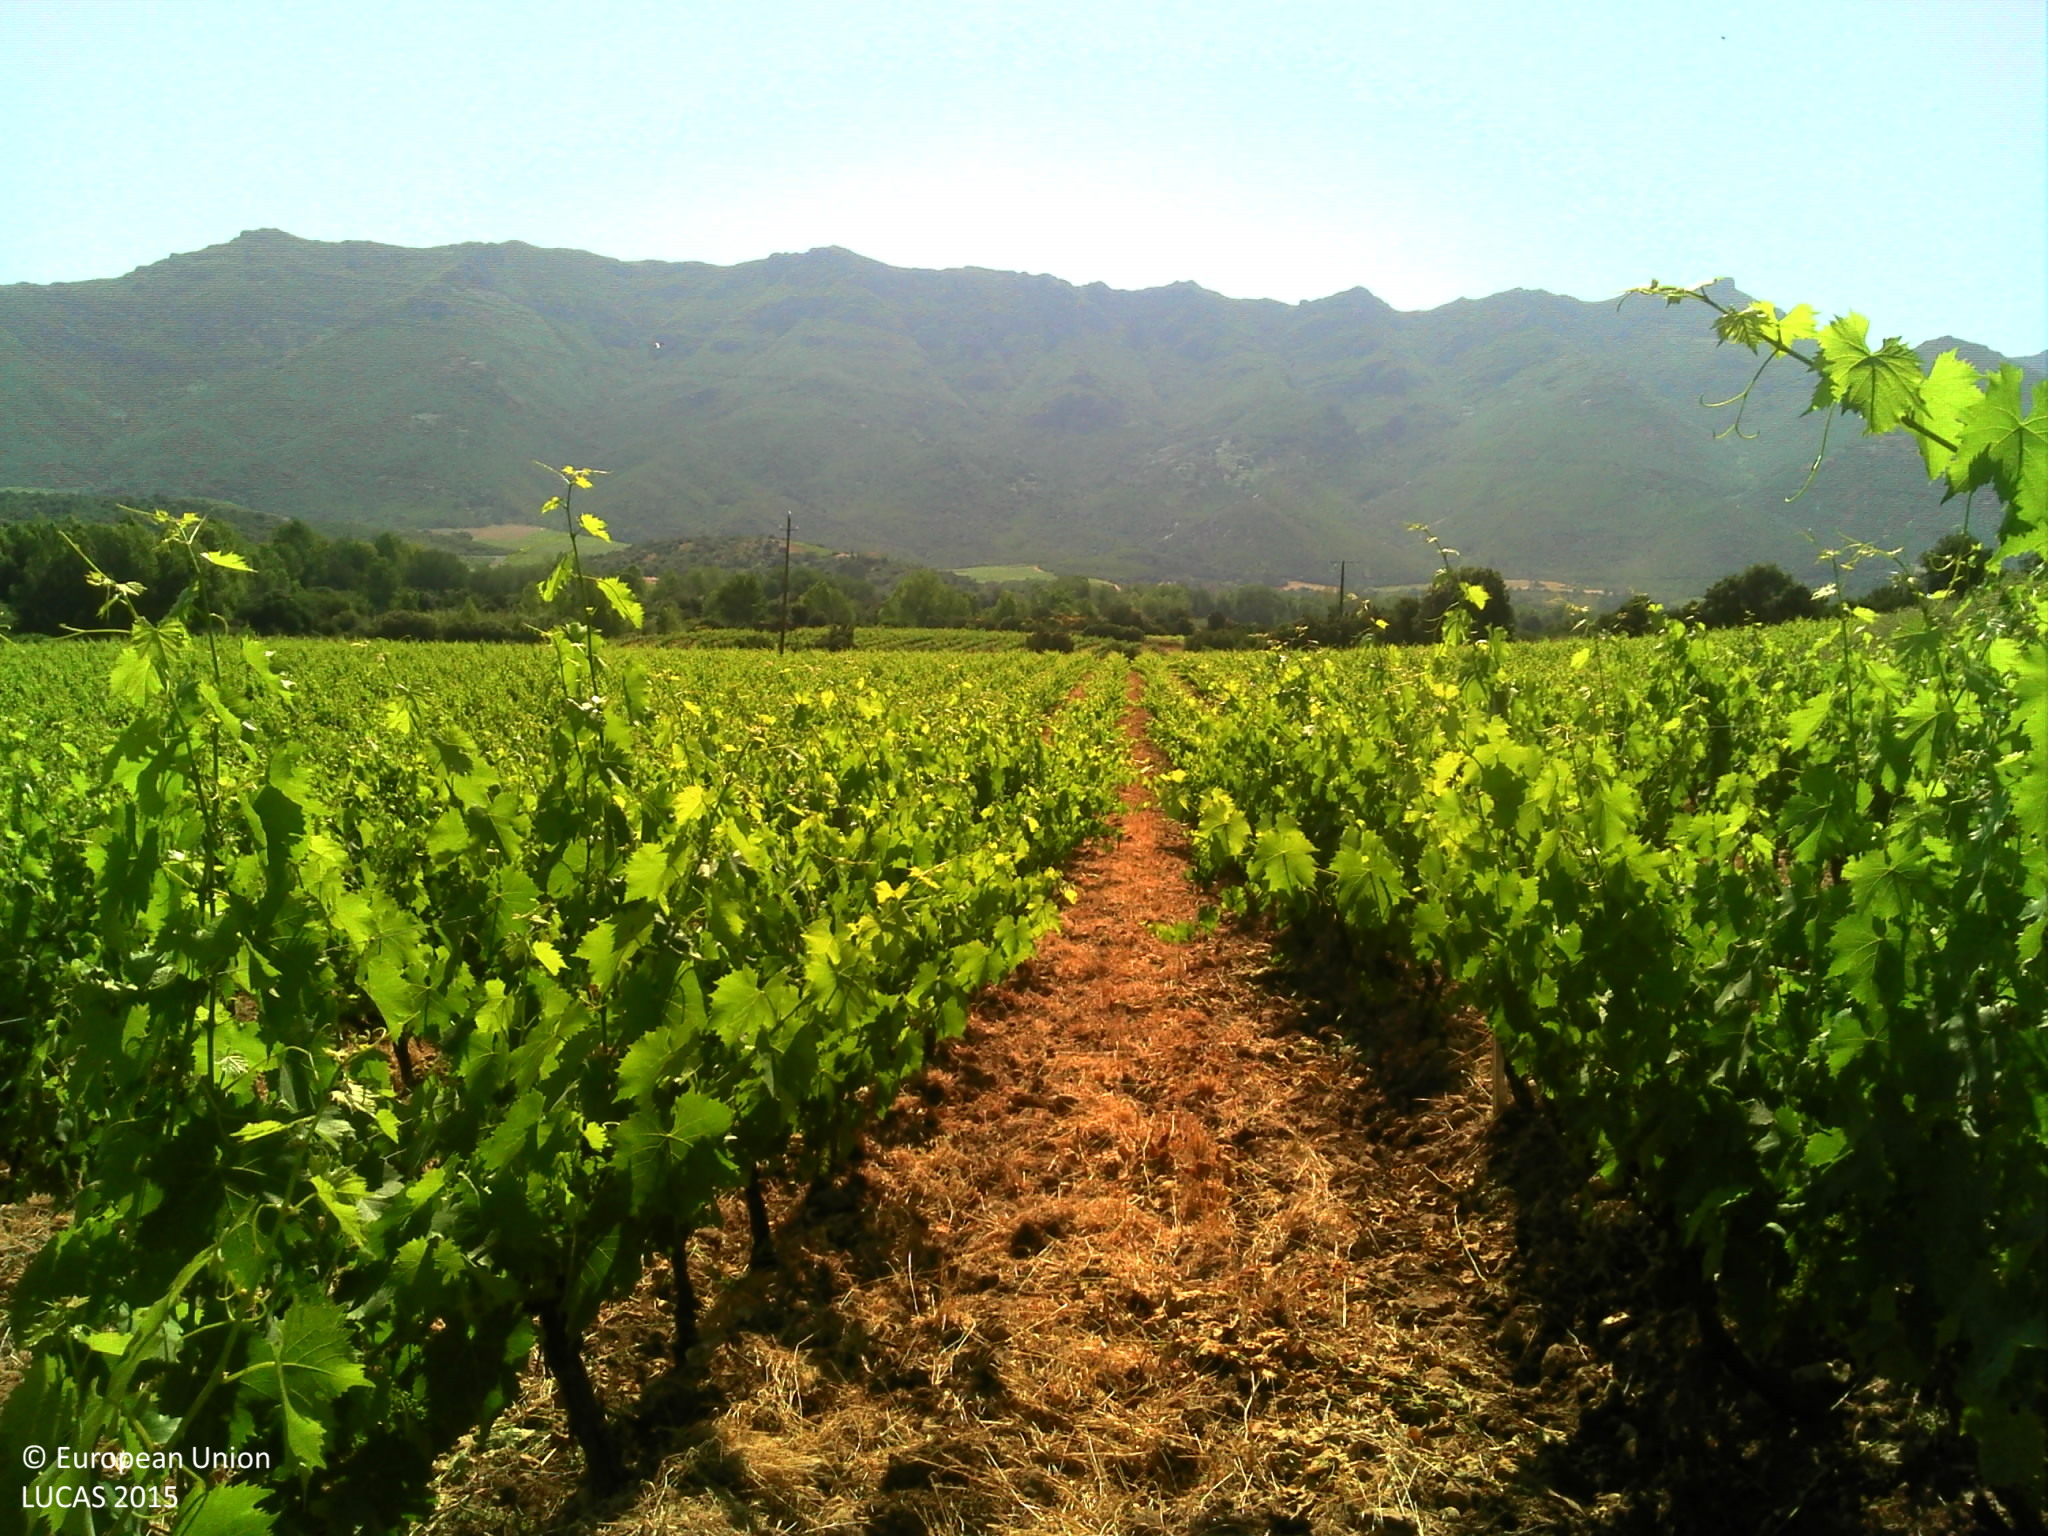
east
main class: Cropland
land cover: Vineyards
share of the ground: 50 - 75 %
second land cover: Other bare soil
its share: > 75 %
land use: Agriculture (excluding fallow land and kitchen gardens)
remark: Tilled/Sowed
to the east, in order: Vineyards; Other bare soil; Electric lines; Vineyards; Tracks; Spontaneously vegetated surfaces; Rivers and streams; Shrubland without tree cover; Spontaneously vegetated surfaces; Vineyards
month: June
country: FR
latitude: 42.6699
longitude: 9.3312
